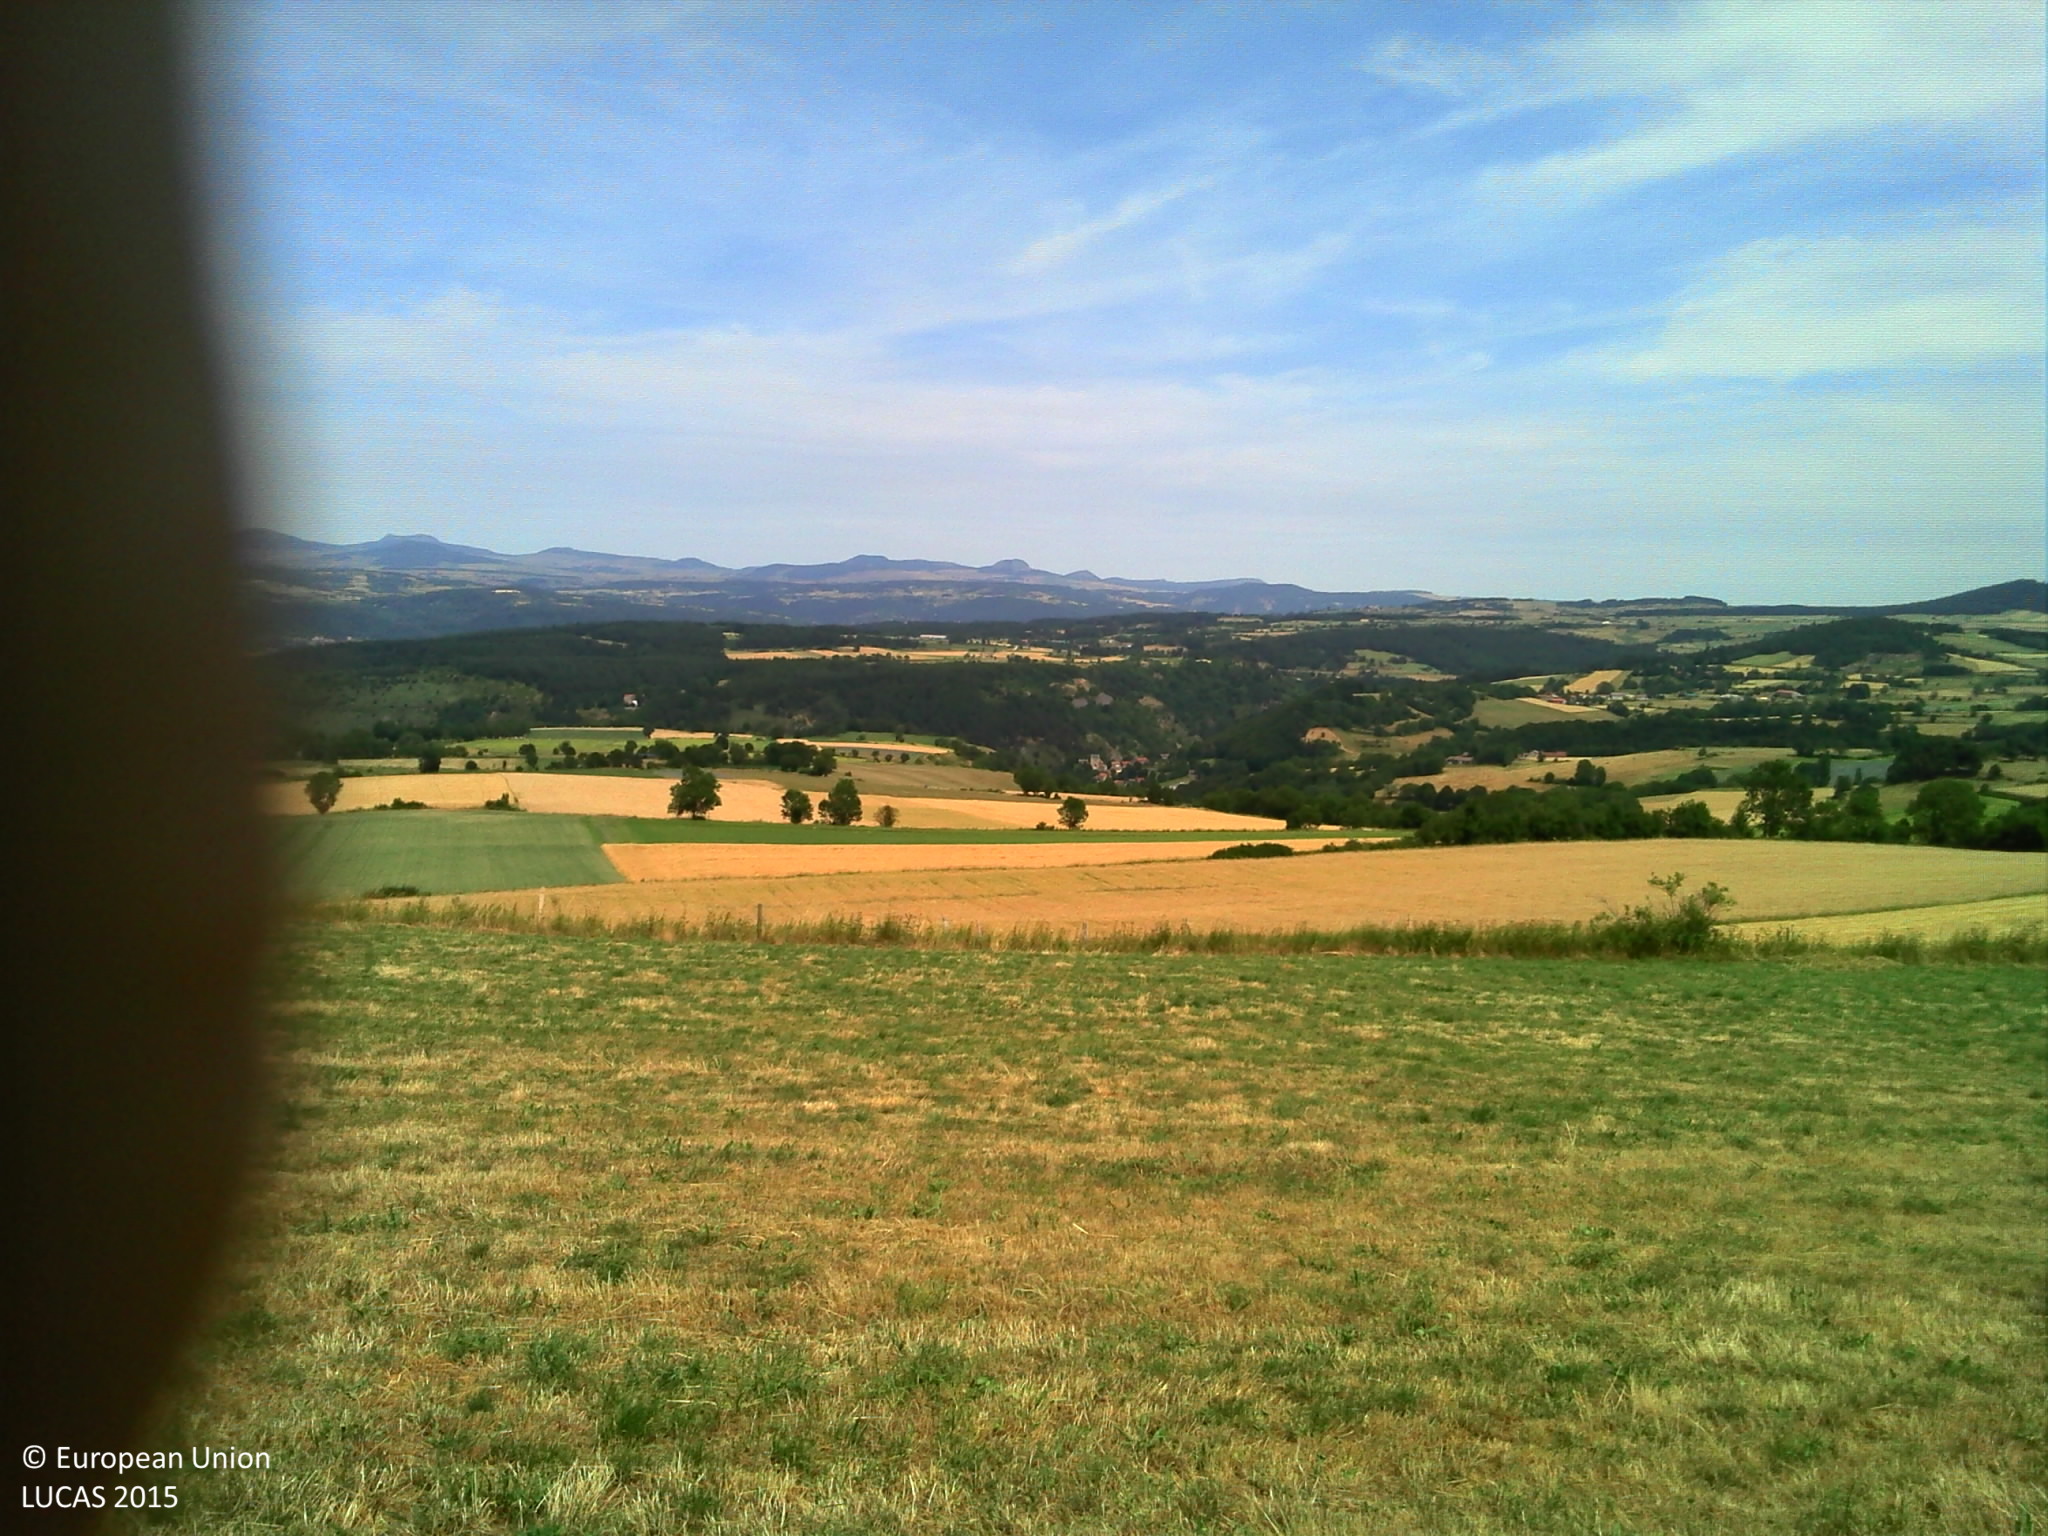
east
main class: Grassland
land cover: Grassland without tree/shrub cover
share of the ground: > 75 %
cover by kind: herbaceous plants 100 %
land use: Agriculture (excluding fallow land and kitchen gardens)
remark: Harvested field
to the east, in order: Grassland without tree/shrub cover; Fences; Barley; Fences; Grass margins; Barley
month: July
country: FR
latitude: 44.8397
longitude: 3.8946
